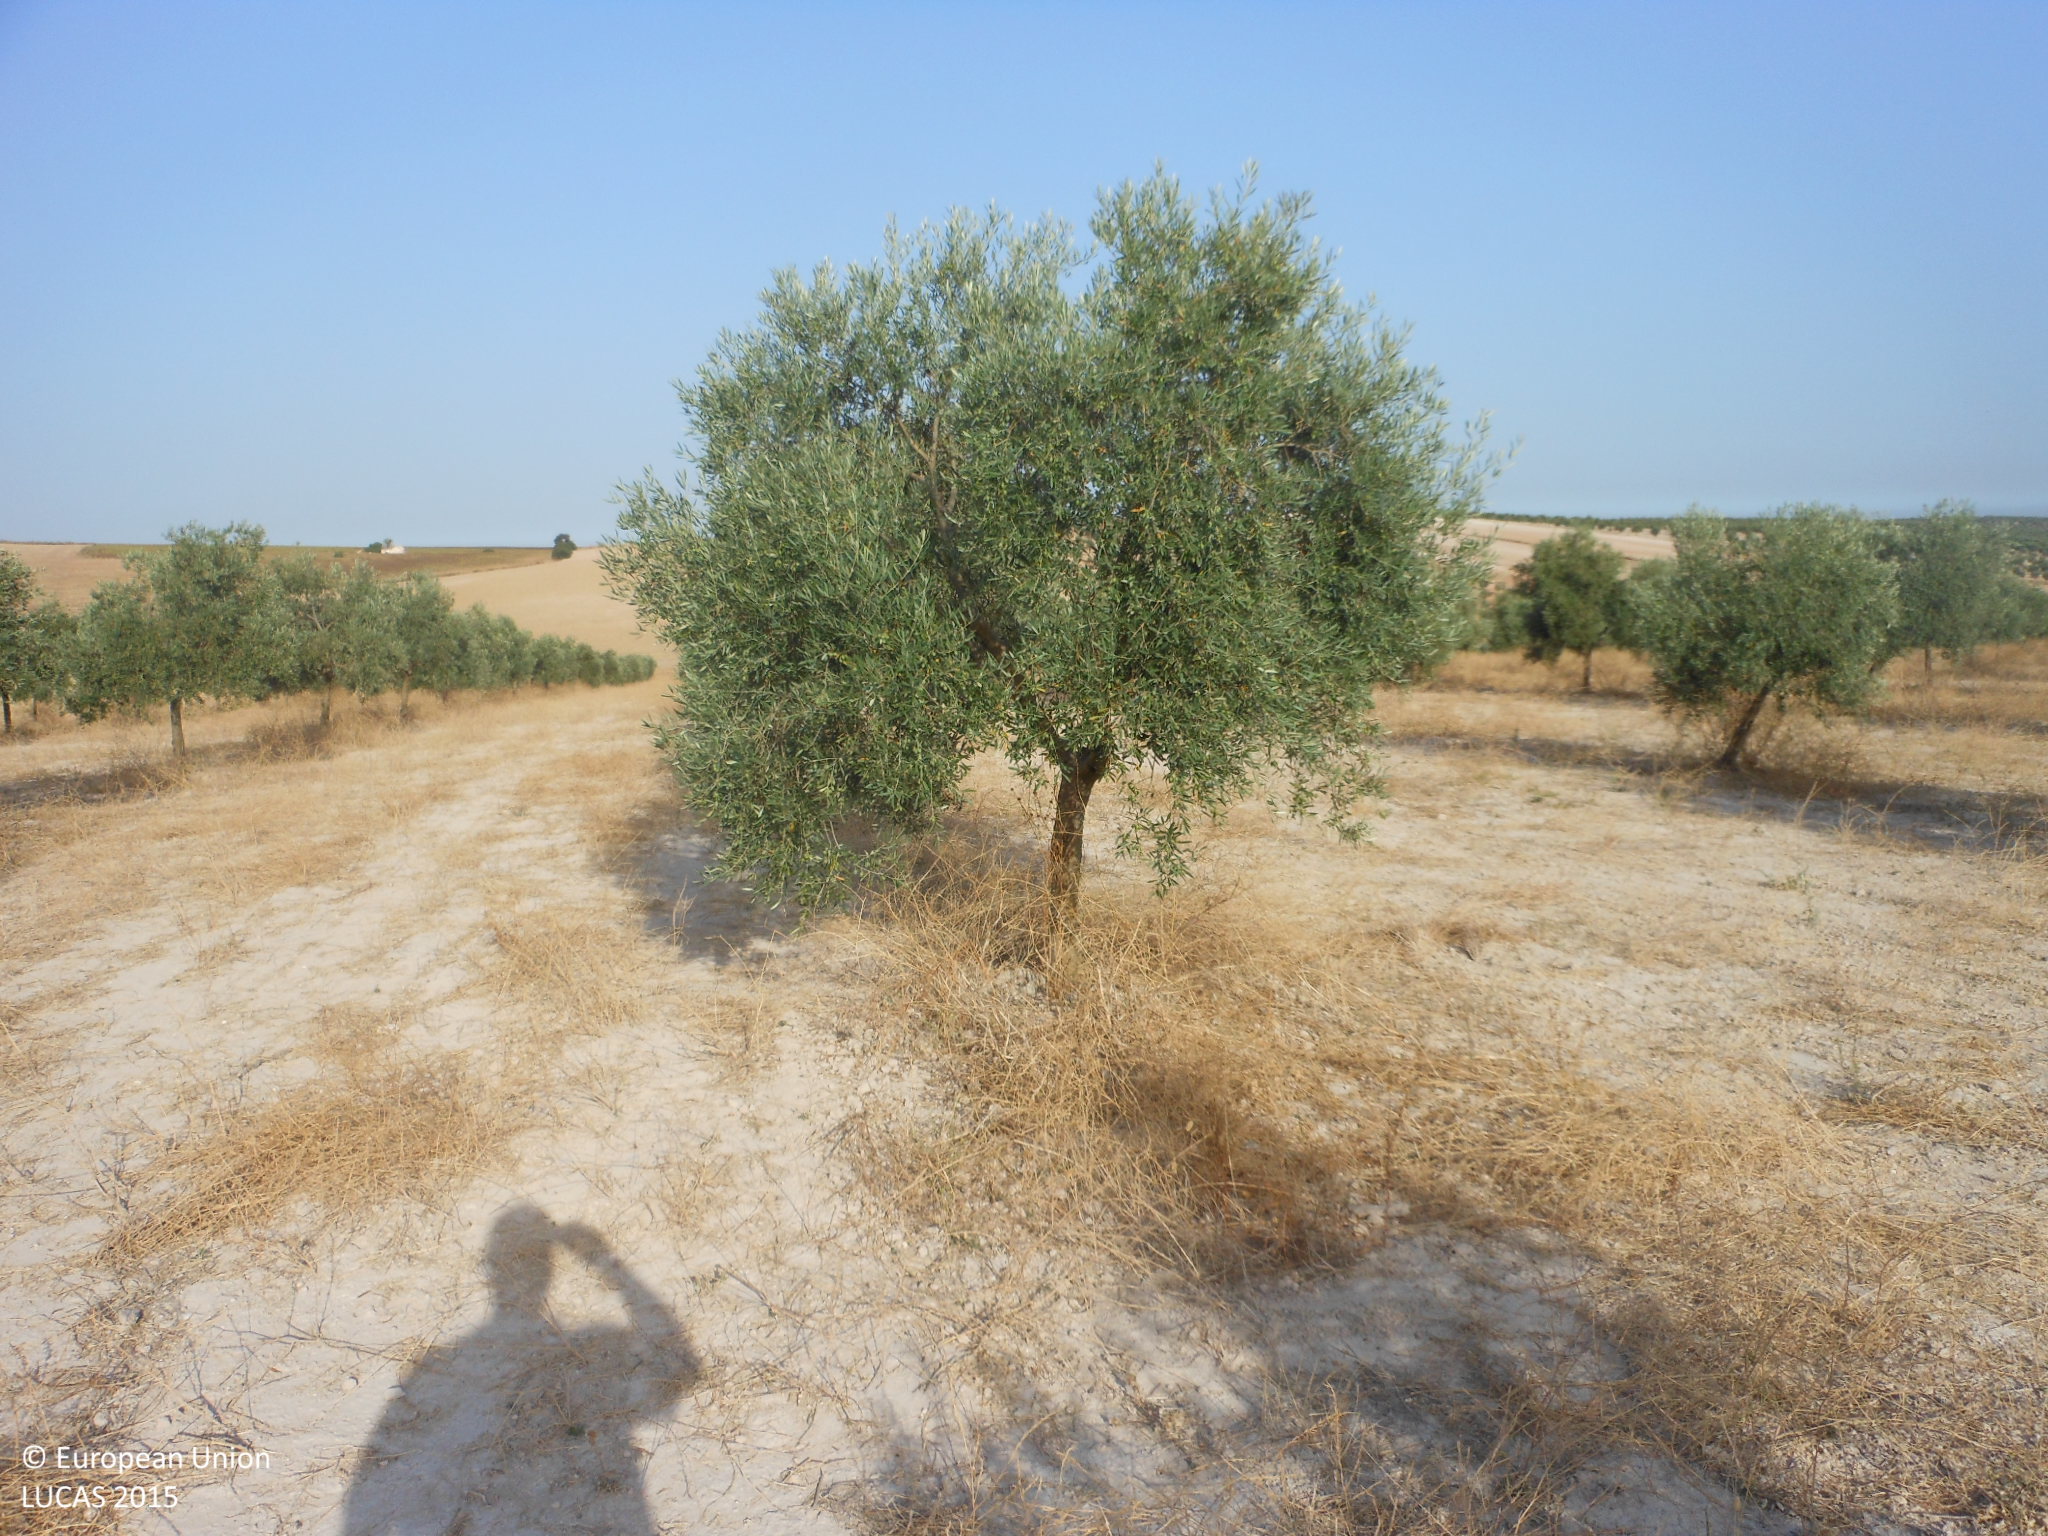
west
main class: Cropland
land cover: Olive groves
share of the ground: 25 - 50 %
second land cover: Spontaneously vegetated surfaces
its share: 10 - 25 %
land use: Agriculture (excluding fallow land and kitchen gardens)
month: July
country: ES
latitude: 37.4612
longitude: -5.1734
